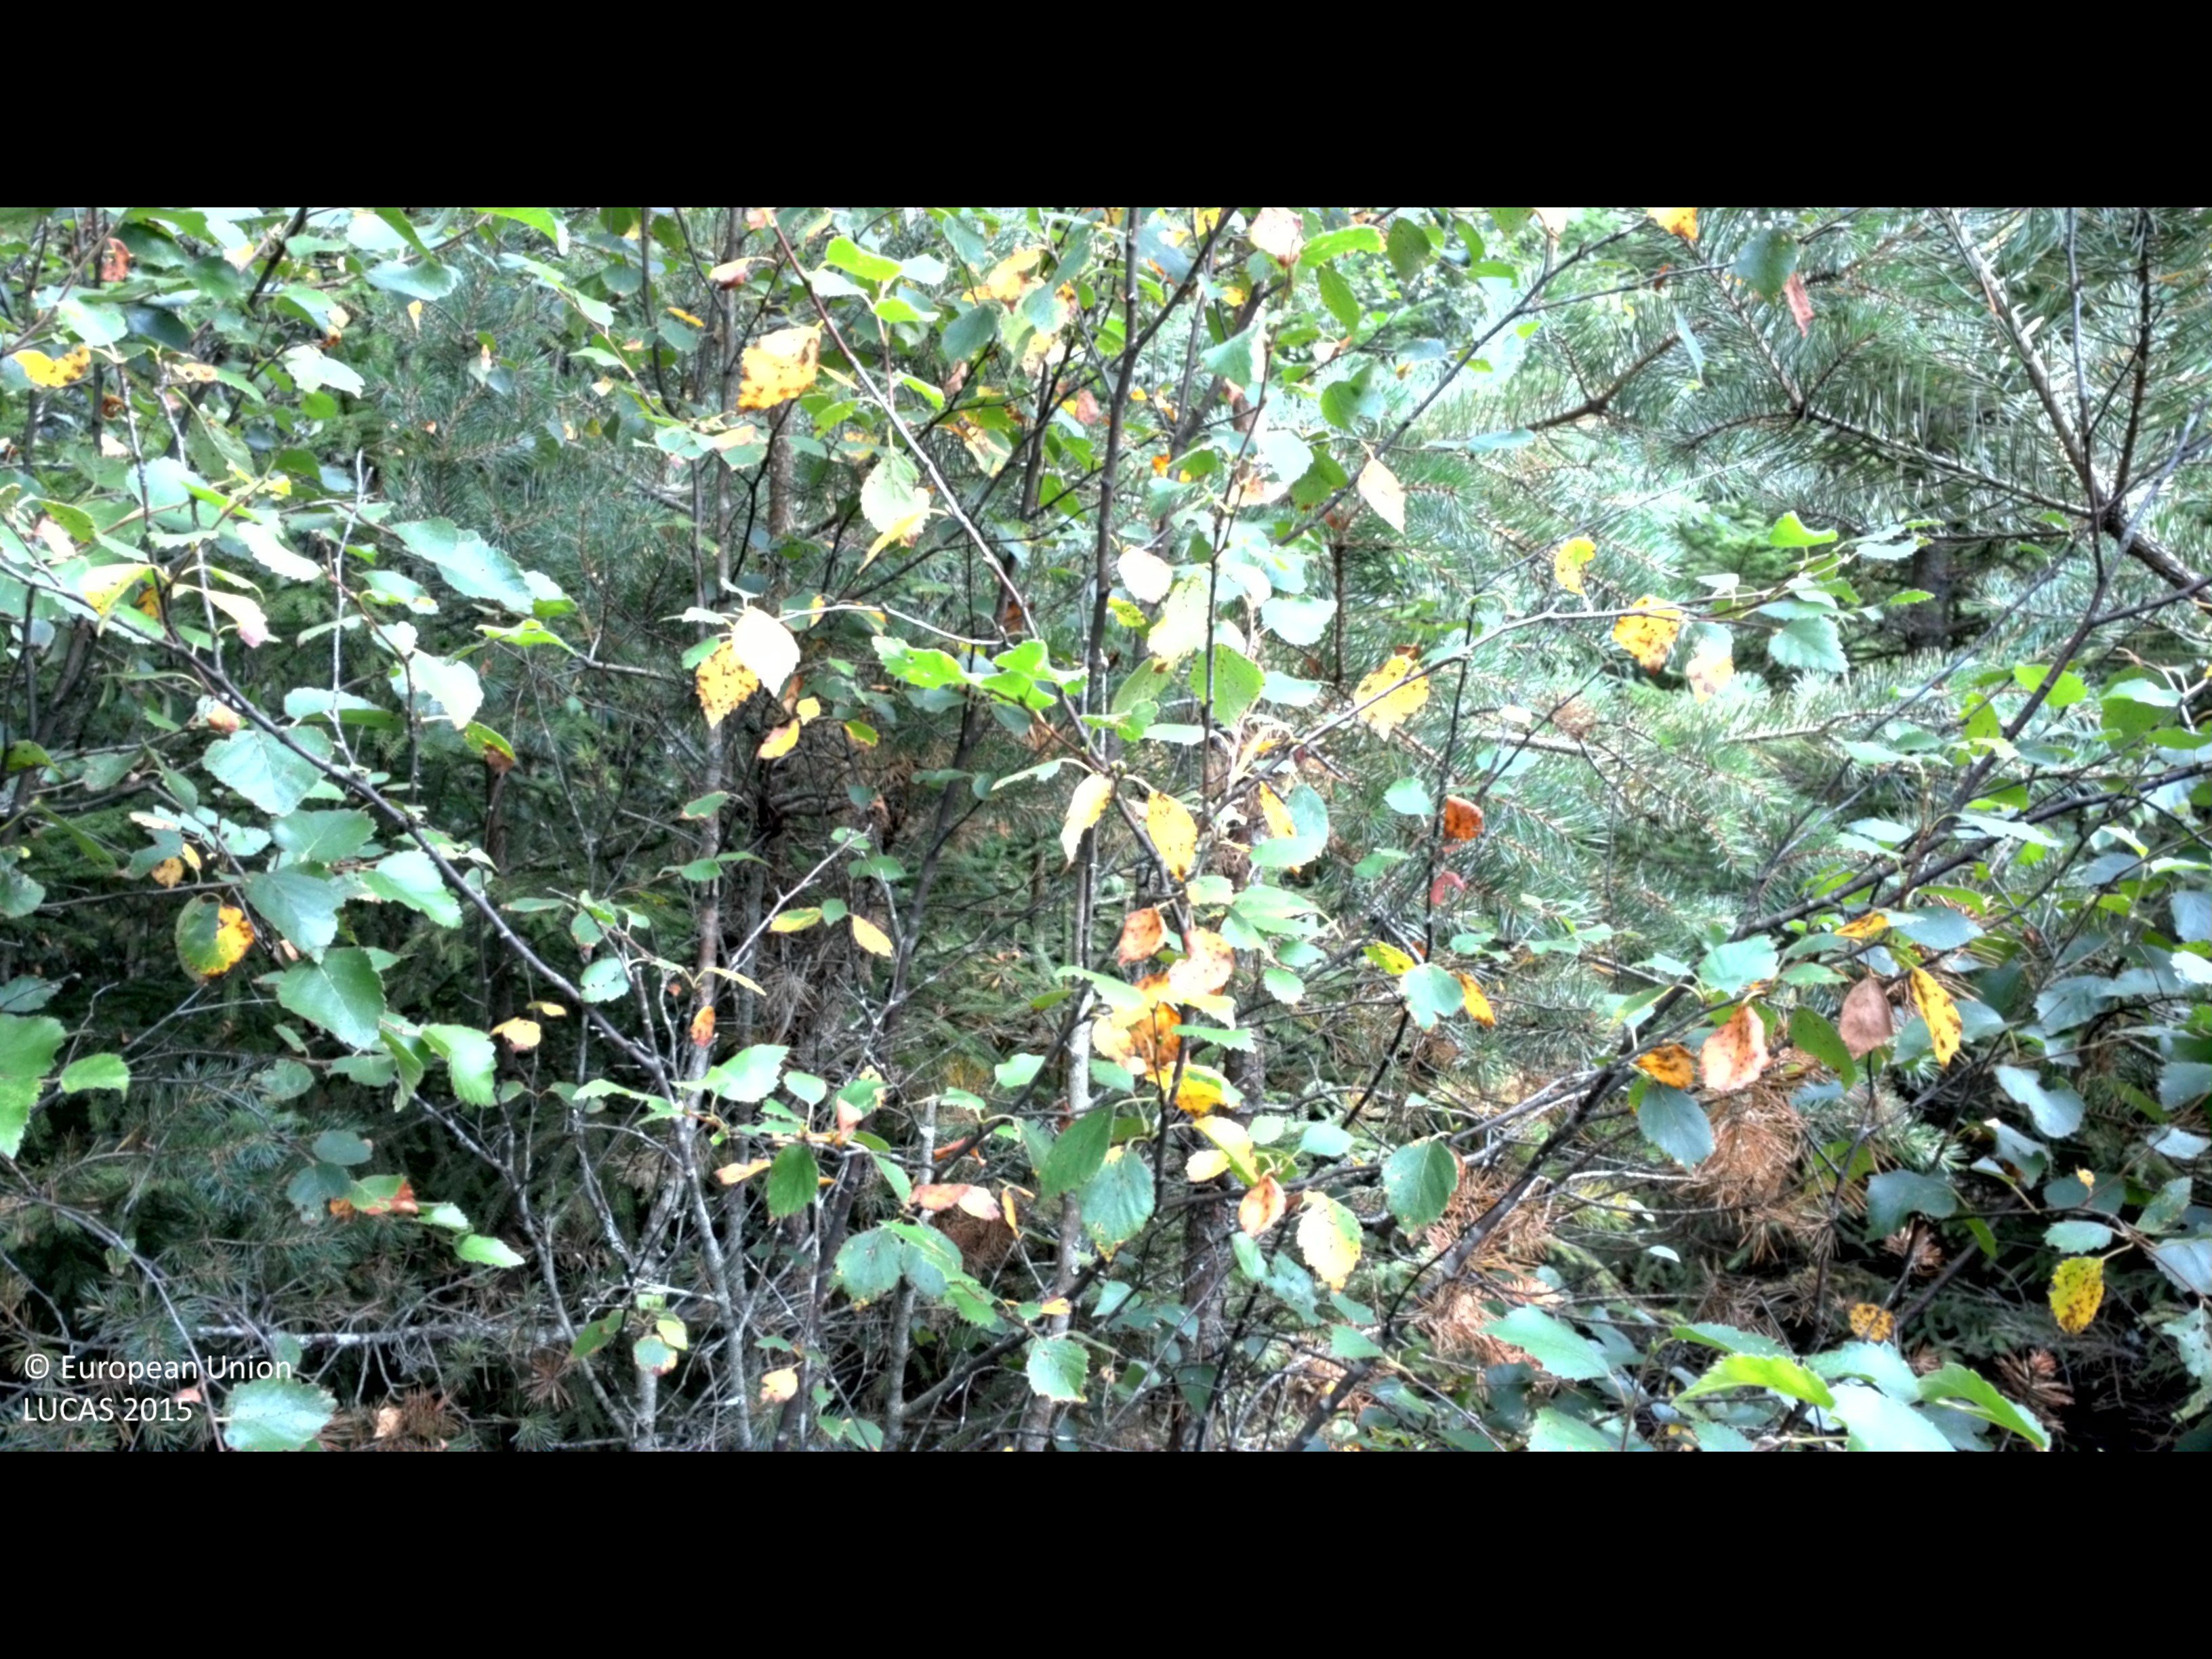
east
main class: Woodland
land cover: Spruce dominated mixed woodland
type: boreal forest
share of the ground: > 75 %
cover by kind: broadleaved forest trees 50 %, coniferous forest trees 40 %, herbaceous plants 10 %
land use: Forestry
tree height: > 5 m
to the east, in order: Spruce dominated mixed woodland; Broadleaved woodland; Electric lines; Grass margins; Paved roads, cycling and walking lanes; Grass margins; Spruce dominated mixed woodland
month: August
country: SE
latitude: 56.9058
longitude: 13.7897
